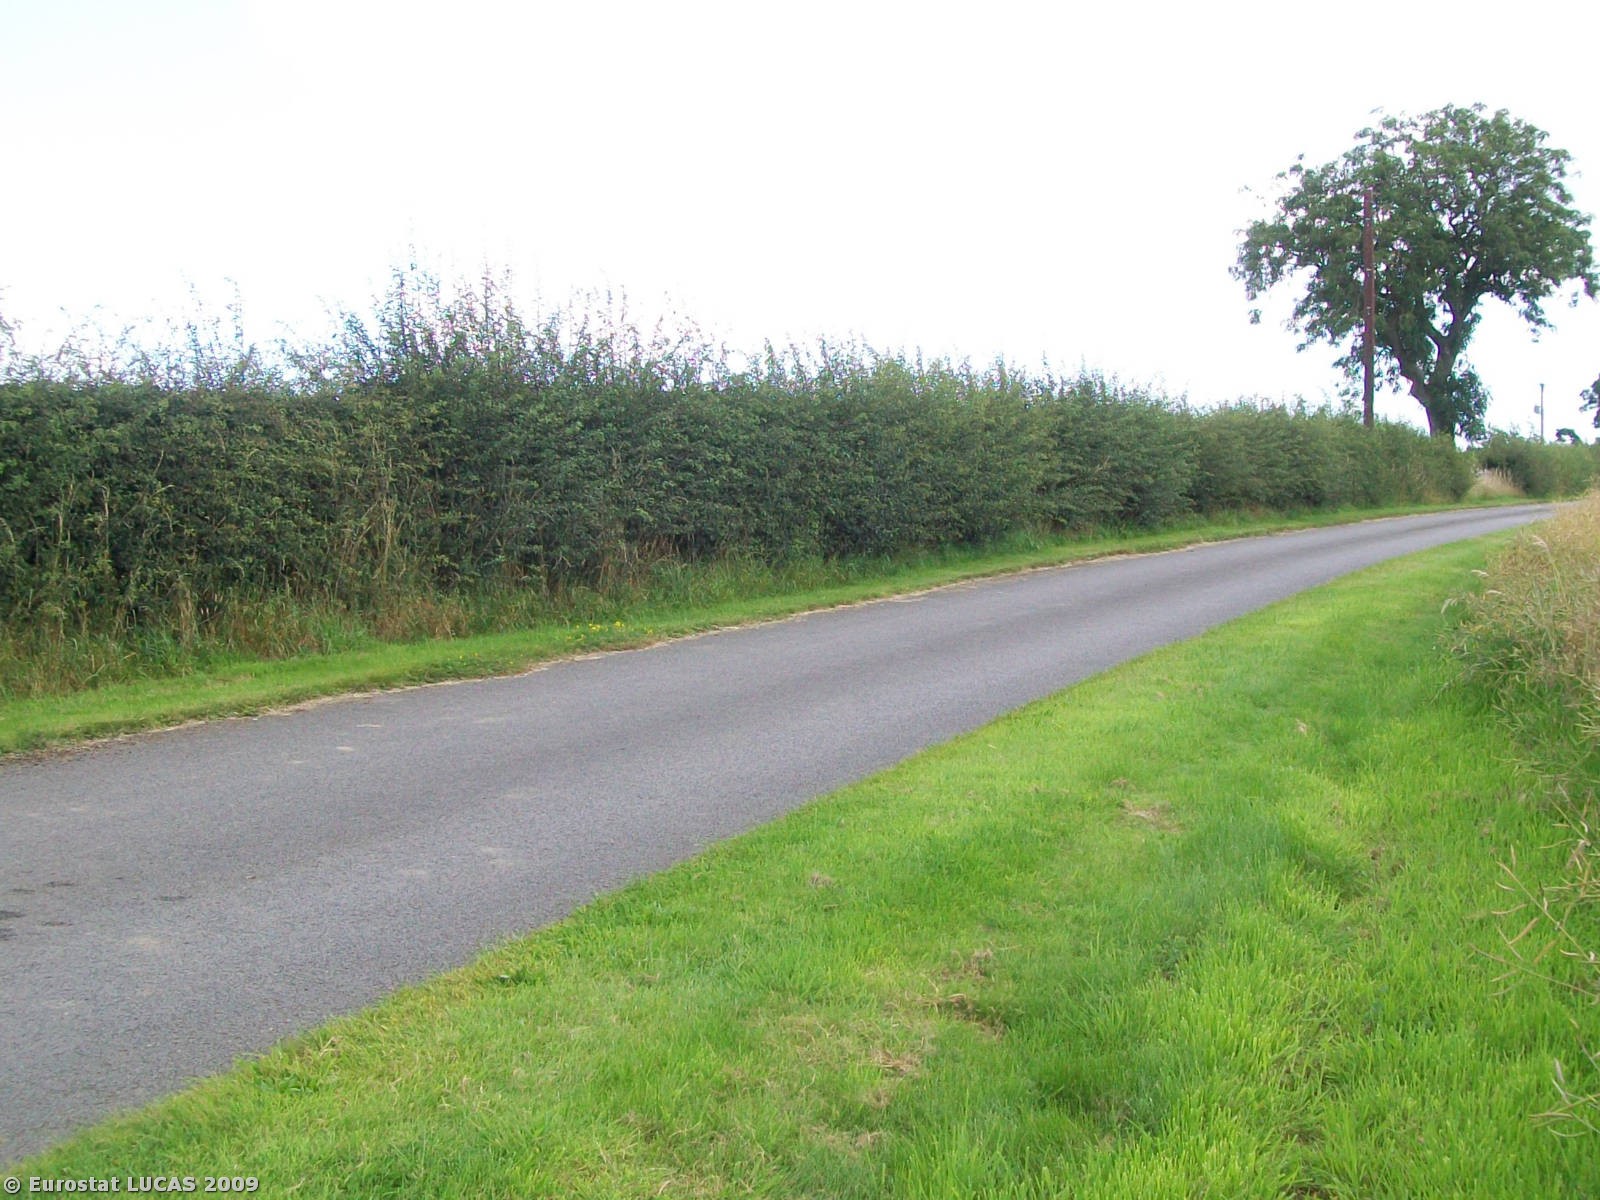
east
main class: Cropland
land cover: Rape and turnip rape
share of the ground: < 10 %
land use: Agriculture (excluding fallow land and kitchen gardens)
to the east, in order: Rape and turnip rape; Arable land (only in case pi)
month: August
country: GB
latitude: 54.4933
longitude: -1.2380
